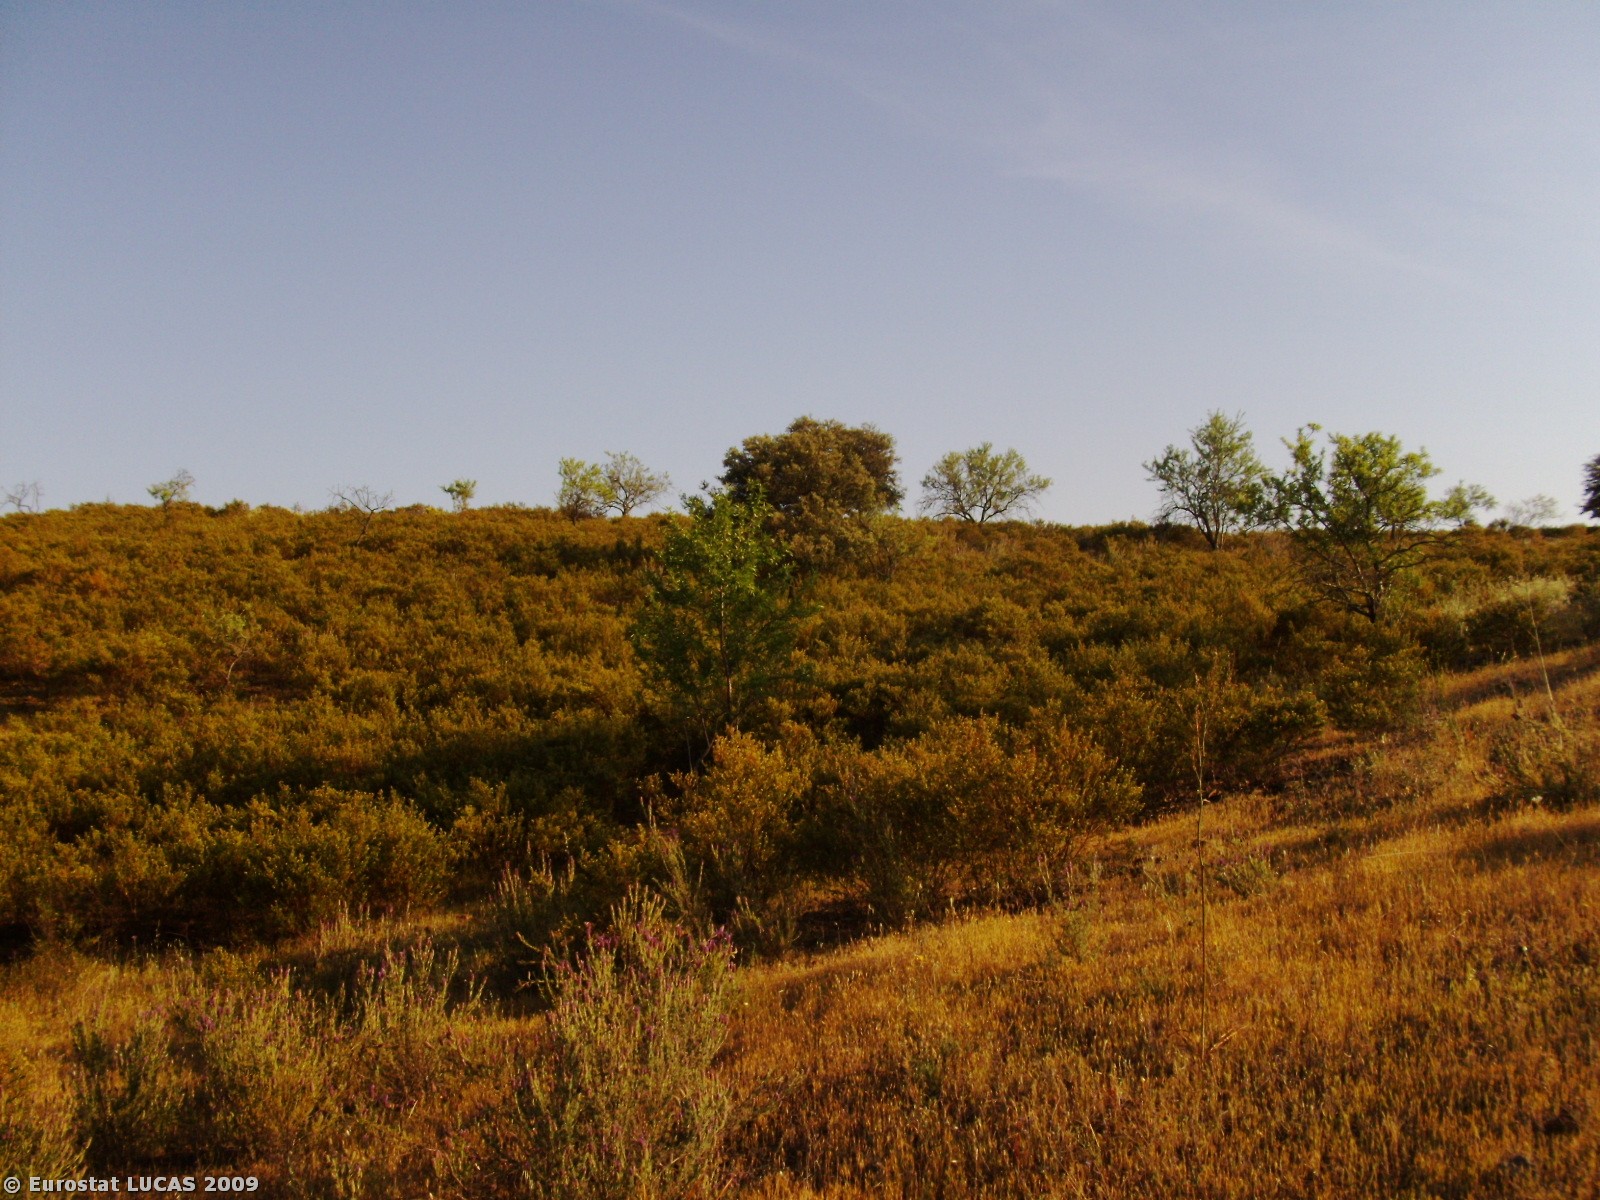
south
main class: Cropland
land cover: Olive groves
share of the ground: < 10 %
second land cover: Spontaneously vegetated surfaces
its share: > 75 %
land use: Agriculture (excluding fallow land and kitchen gardens)
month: May
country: PT
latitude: 37.2852
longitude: -7.4529
